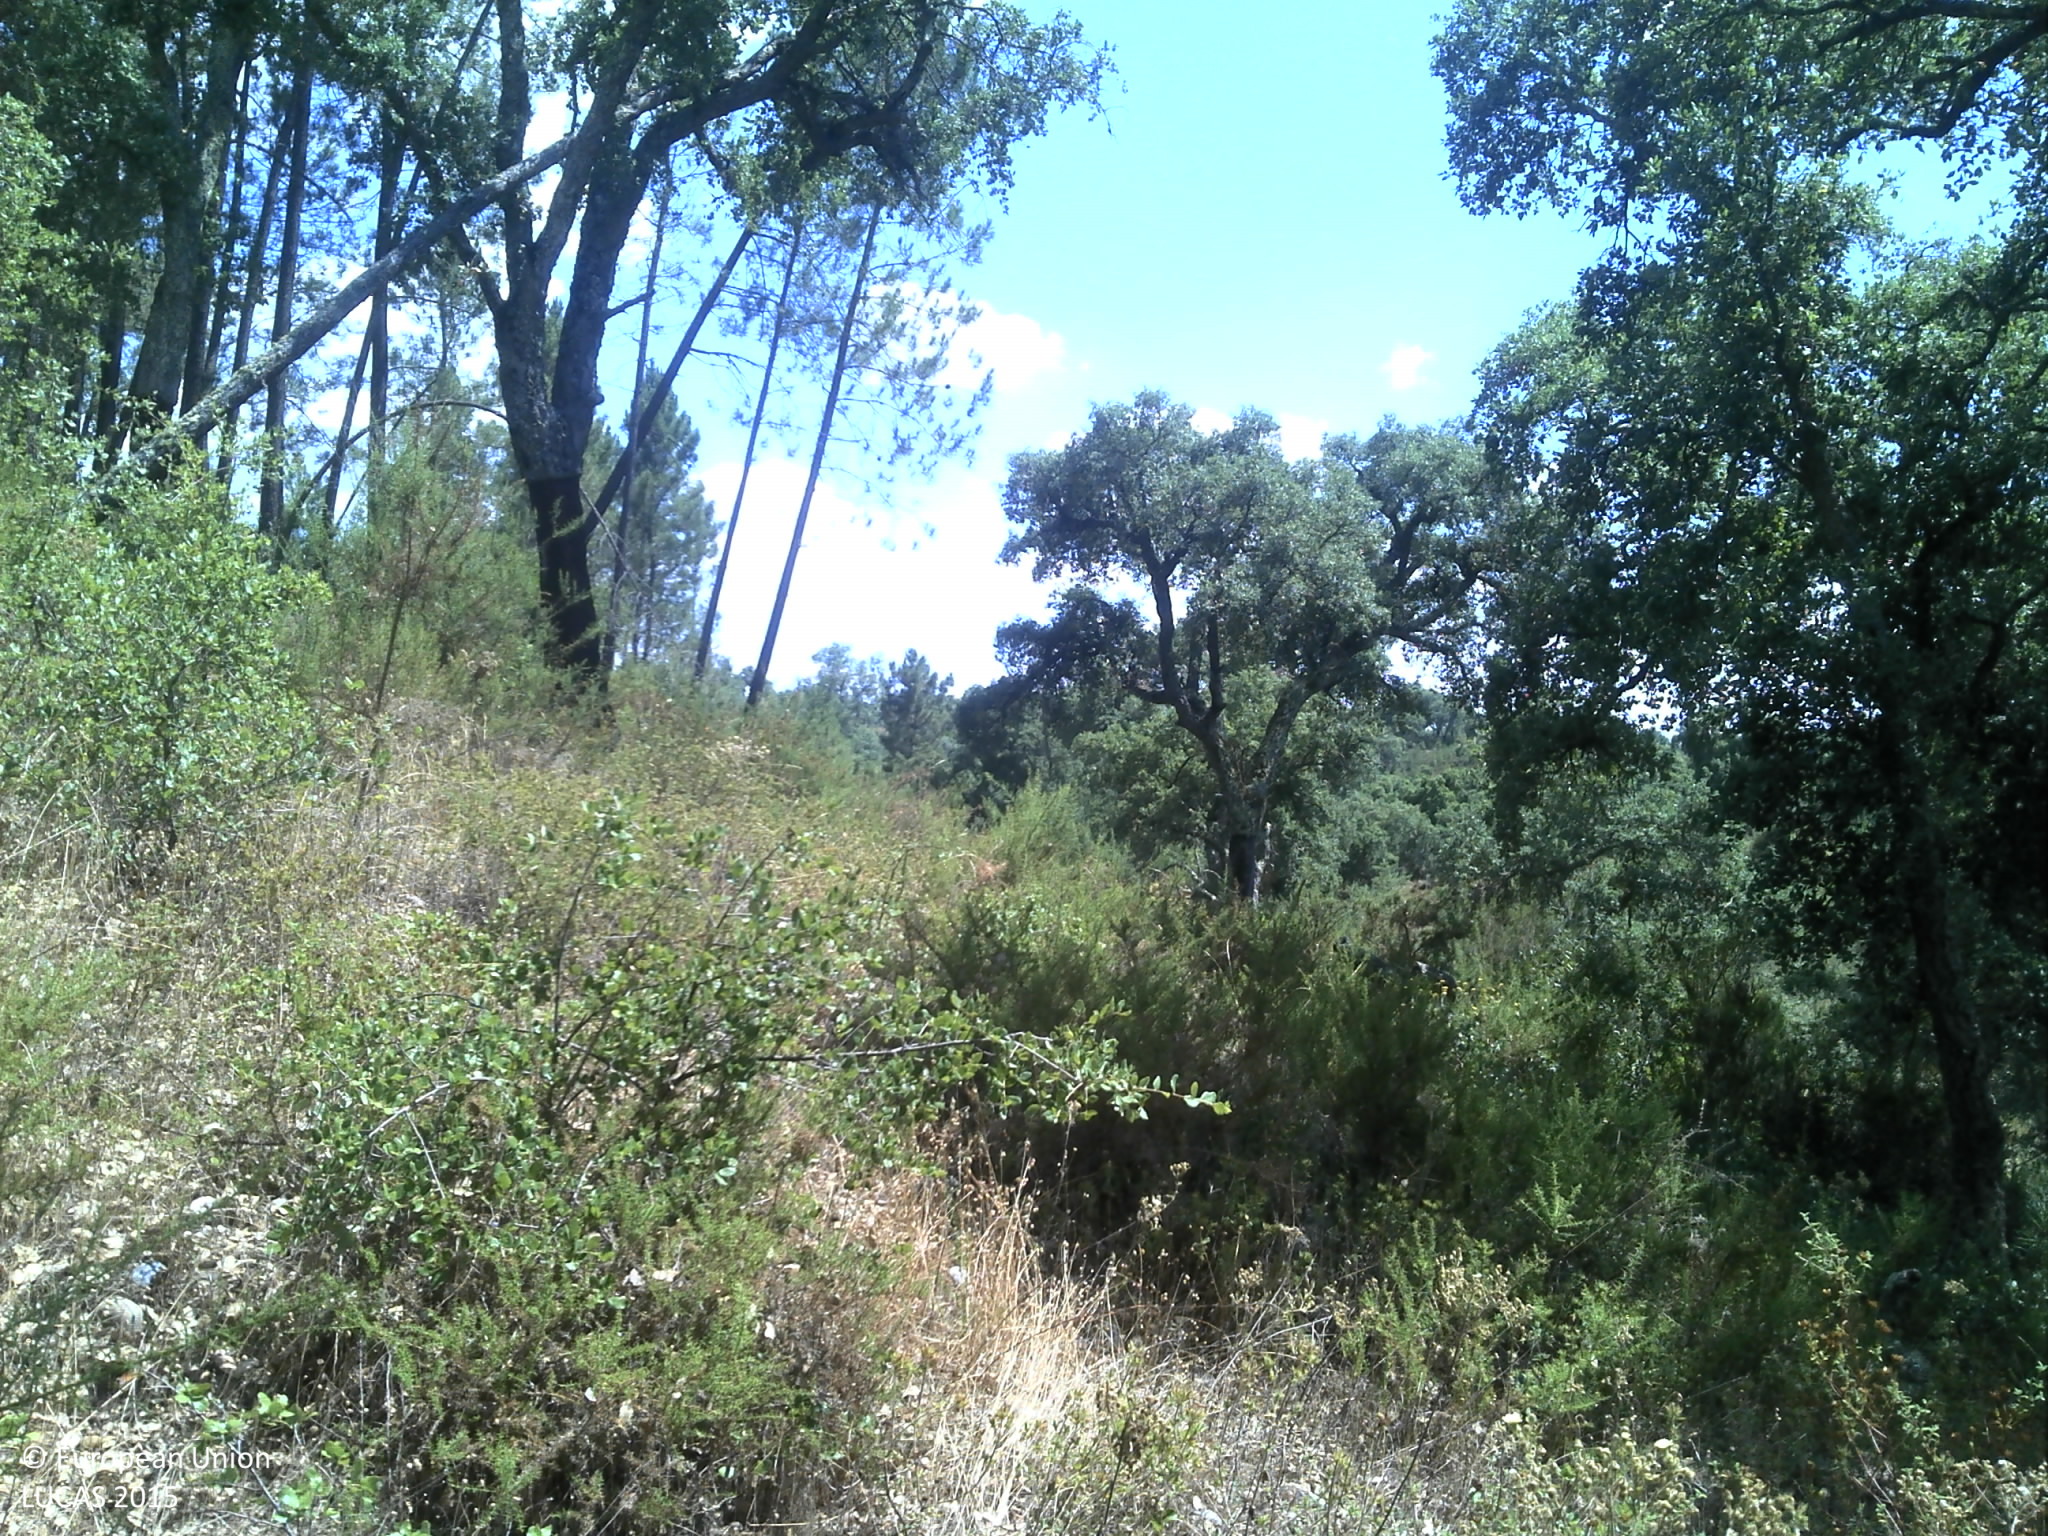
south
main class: Woodland
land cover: Broadleaved woodland
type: broadleaved evergreen forest
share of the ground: 25 - 50 %
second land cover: Grassland without tree/shrub cover
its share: 25 - 50 %
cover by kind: broadleaved forest trees 50 %, unconsolidated bare surface 20 %, shrubs 15 %, herbaceous plants 15 %
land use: Forestry
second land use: Agriculture (excluding fallow land and kitchen gardens)
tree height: > 5 m
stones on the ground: 10 - 25 %
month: June
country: PT
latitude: 39.2832
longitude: -8.2274
